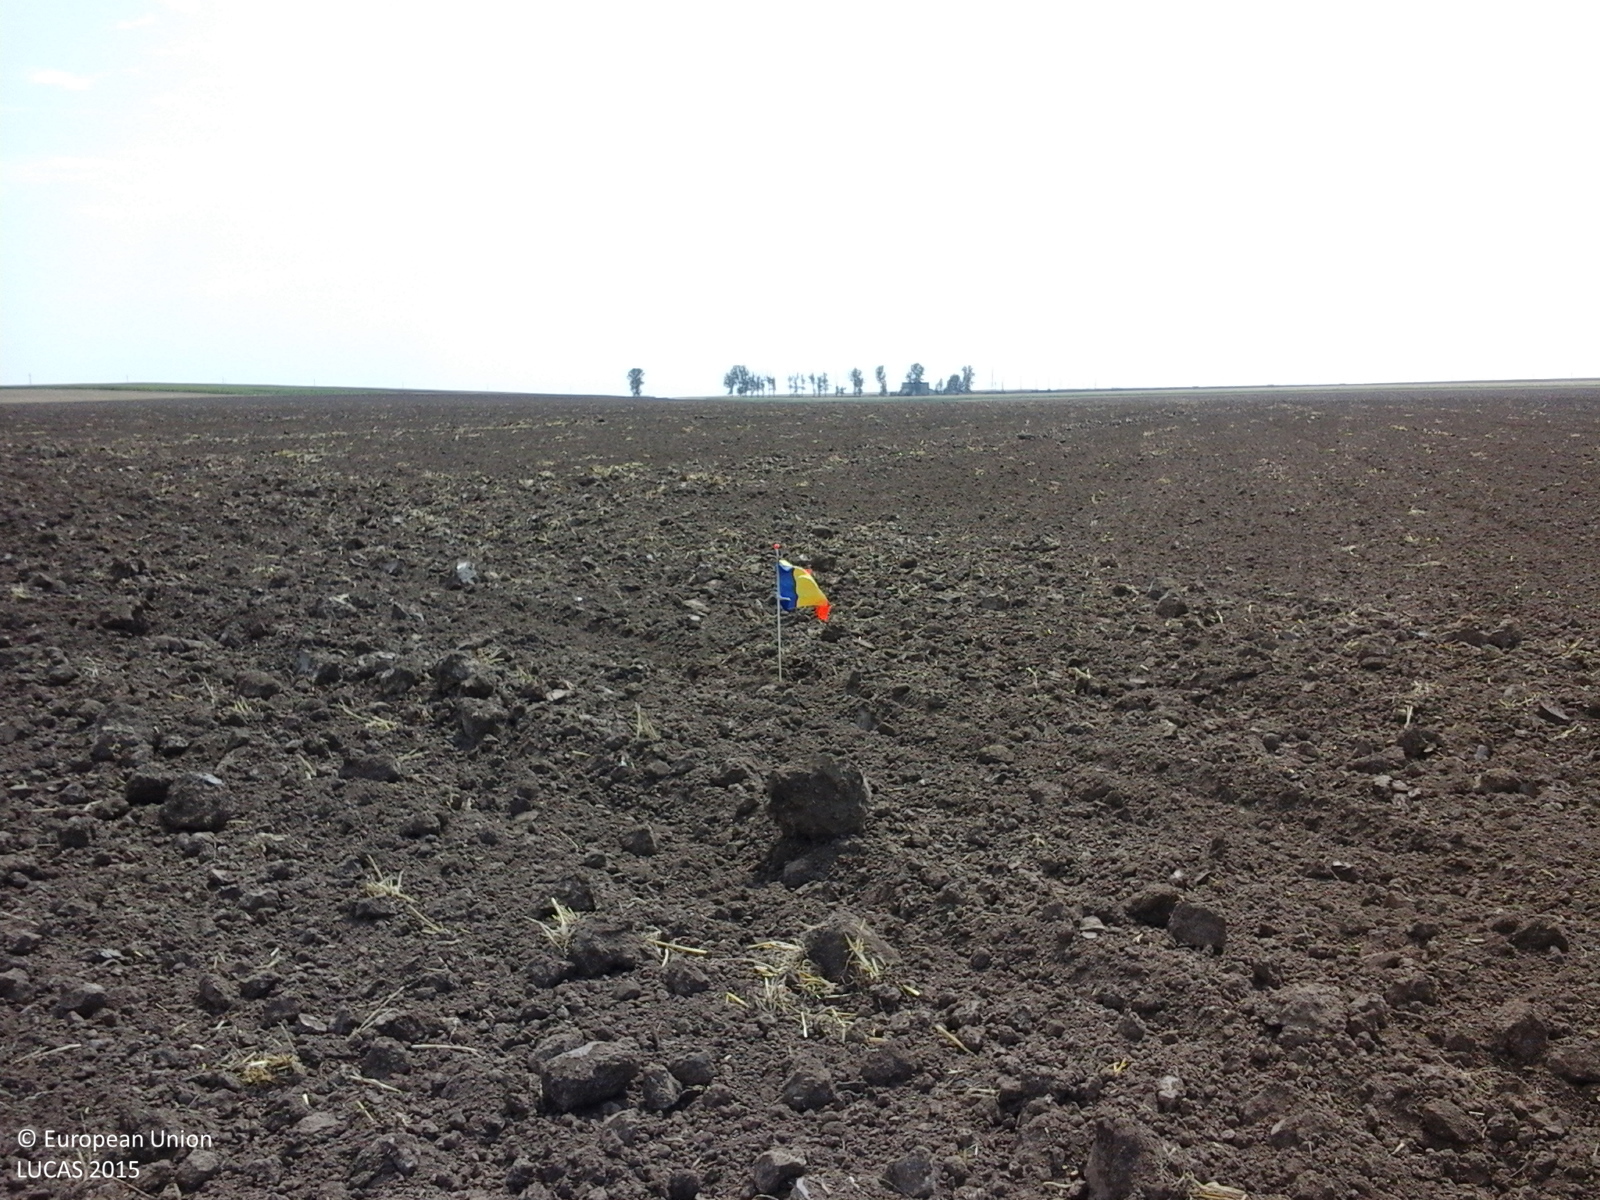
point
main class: Cropland
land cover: Common wheat
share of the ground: < 10 %
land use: Agriculture (excluding fallow land and kitchen gardens)
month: August
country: RO
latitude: 43.9229
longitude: 28.4099
